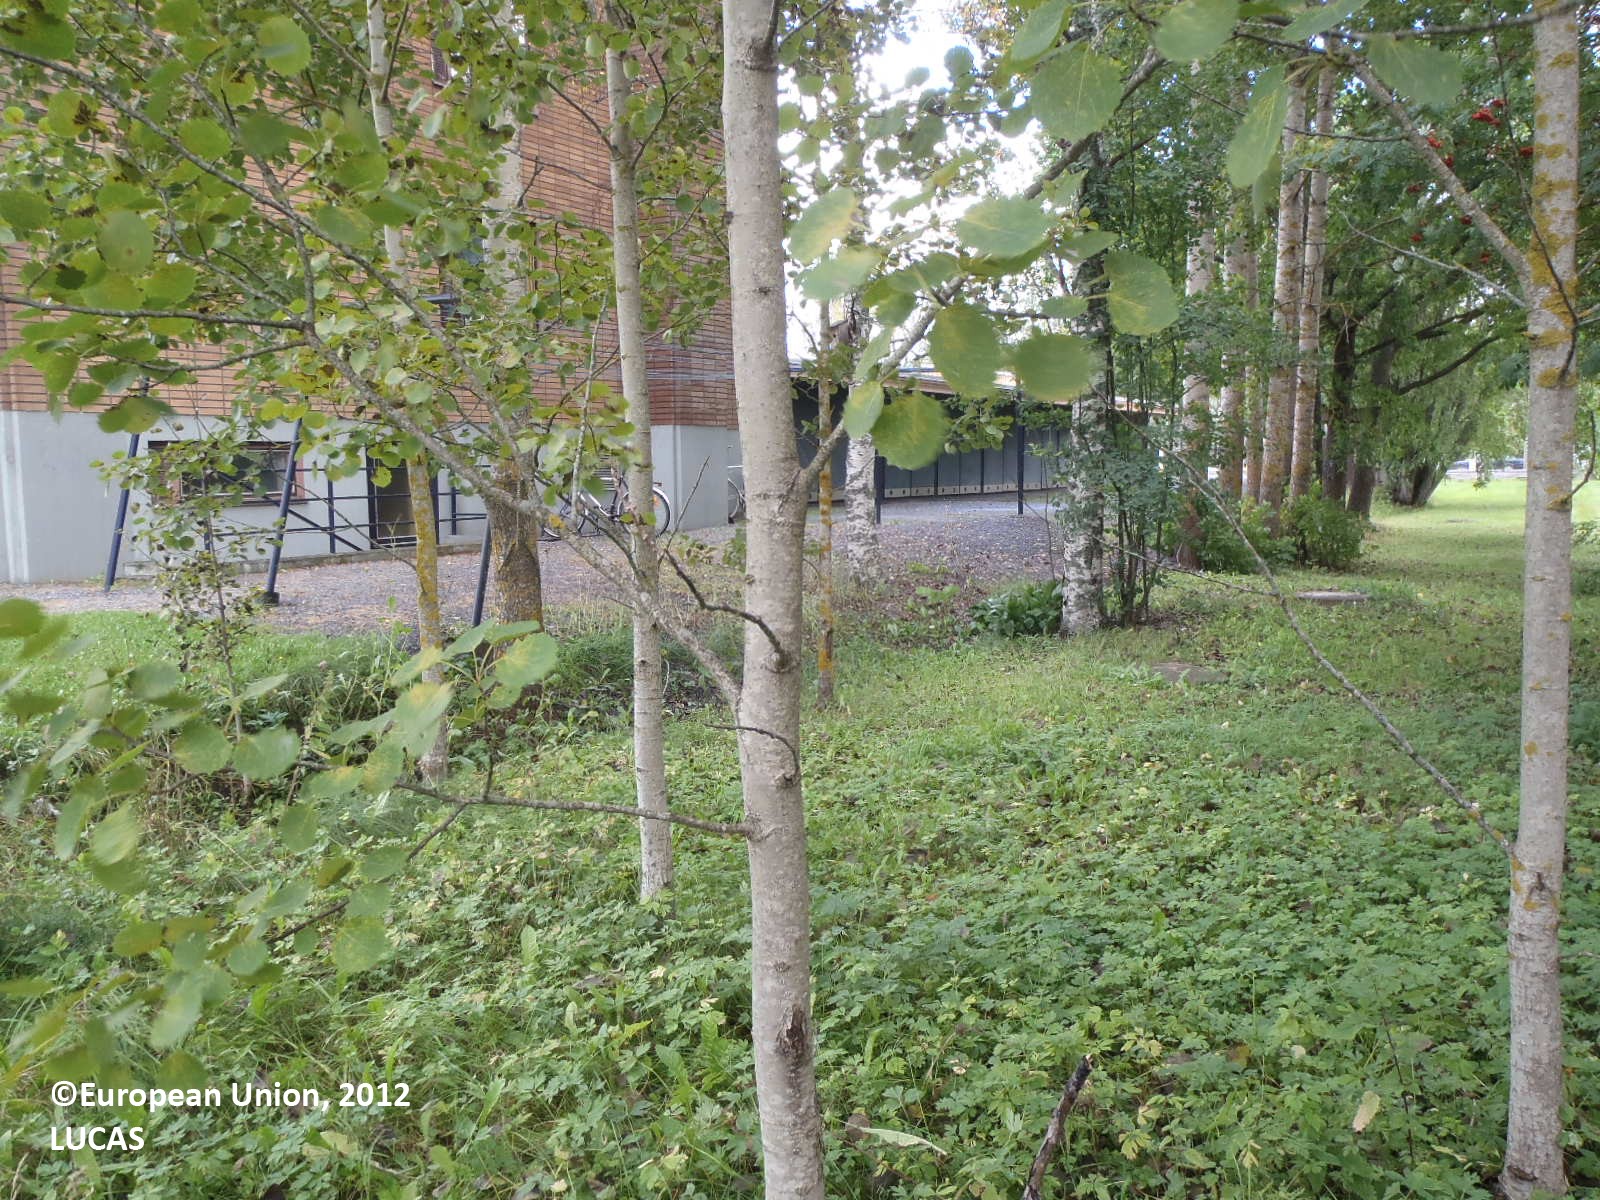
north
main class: Woodland
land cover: Broadleaved woodland
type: boreal forest
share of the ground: > 75 %
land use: Residential
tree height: > 5 m
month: September
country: FI
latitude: 61.2852
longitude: 22.6996
